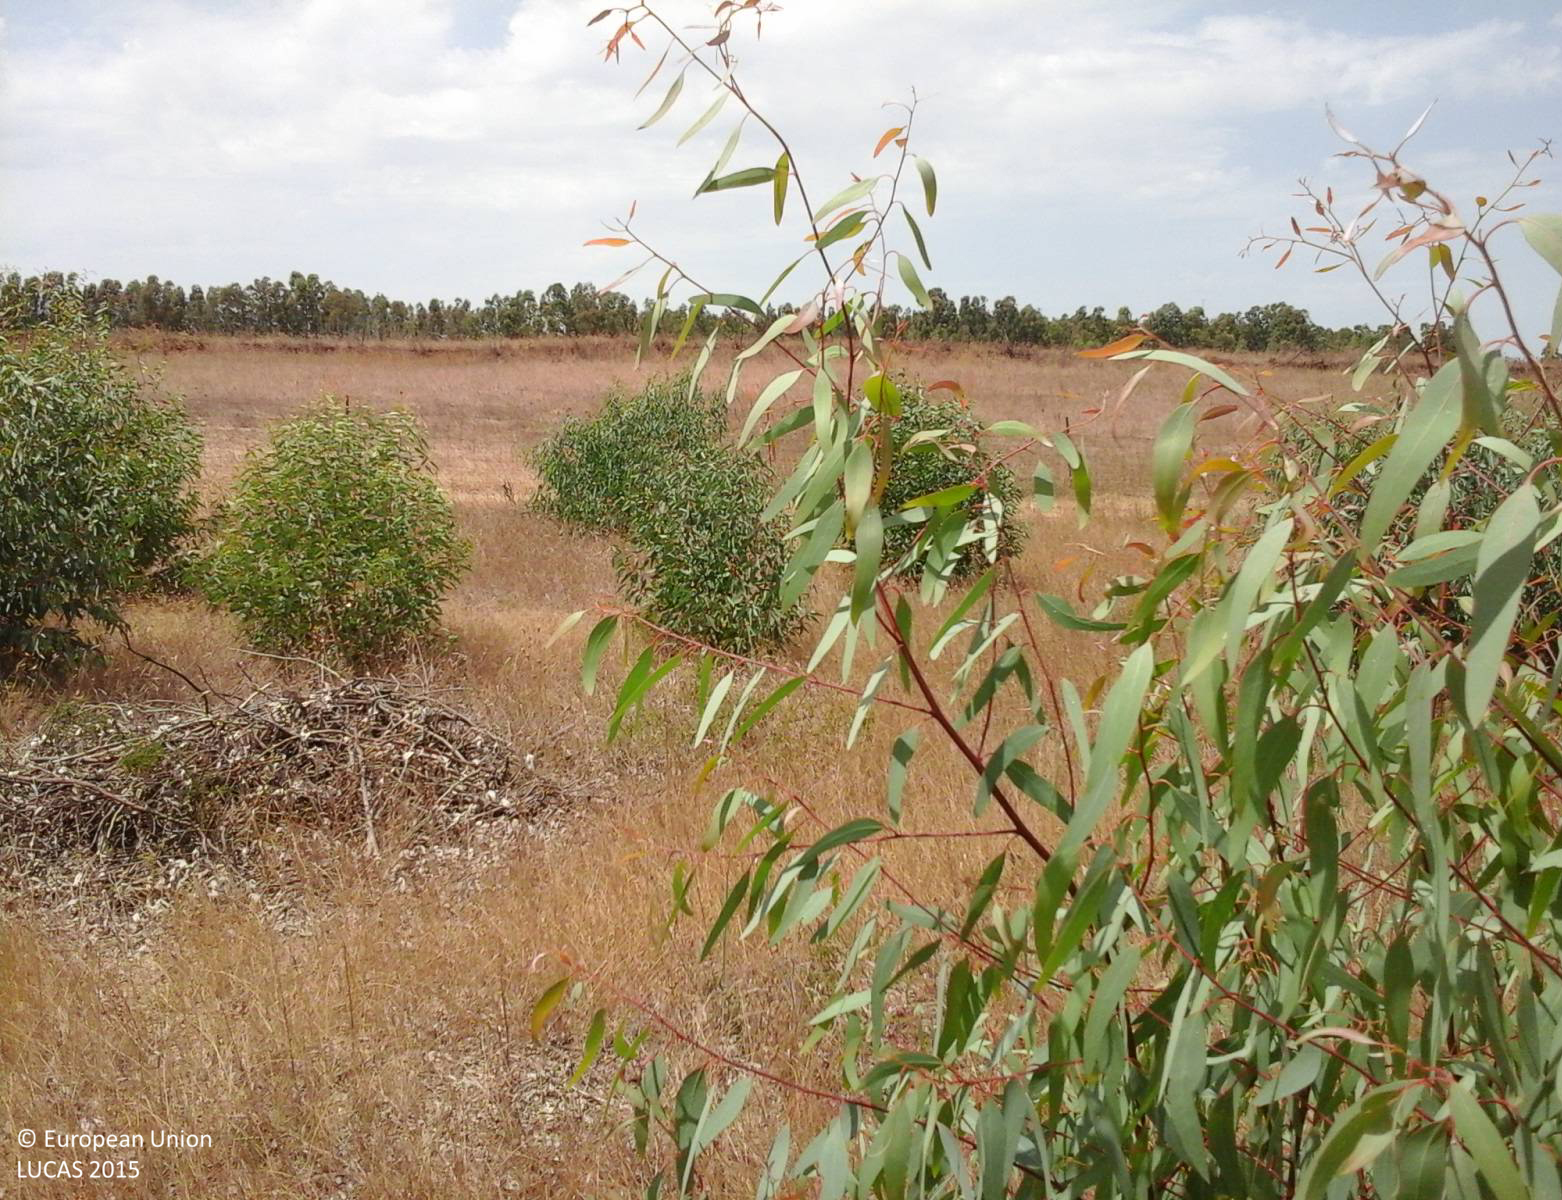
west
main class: Shrubland
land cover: Shrubland without tree cover
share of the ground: > 75 %
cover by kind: shrubs 100 %
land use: Agriculture (excluding fallow land and kitchen gardens)
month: July
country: IT
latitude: 39.4816
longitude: 8.8327
